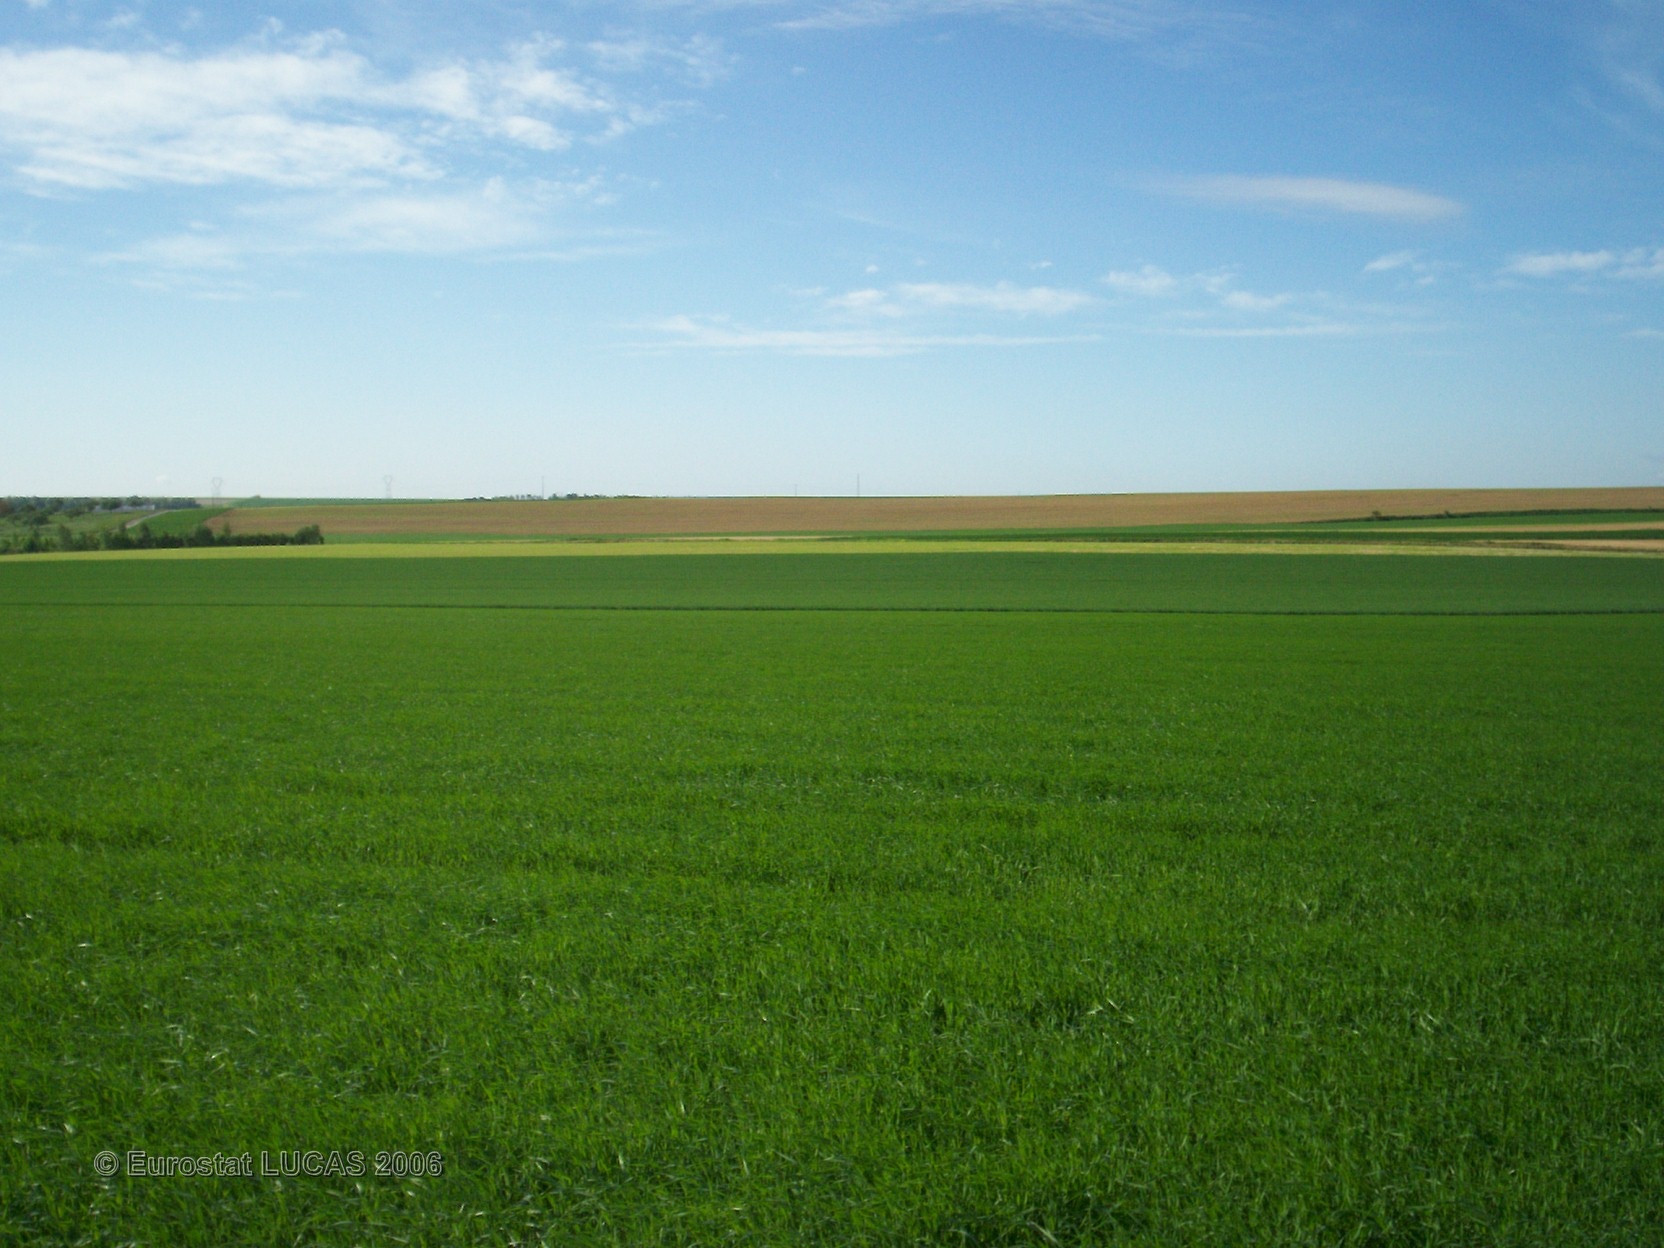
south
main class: Cropland
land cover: Barley
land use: Agriculture (excluding fallow land and kitchen gardens)
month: May
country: FR
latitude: 49.4343
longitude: 4.4113
